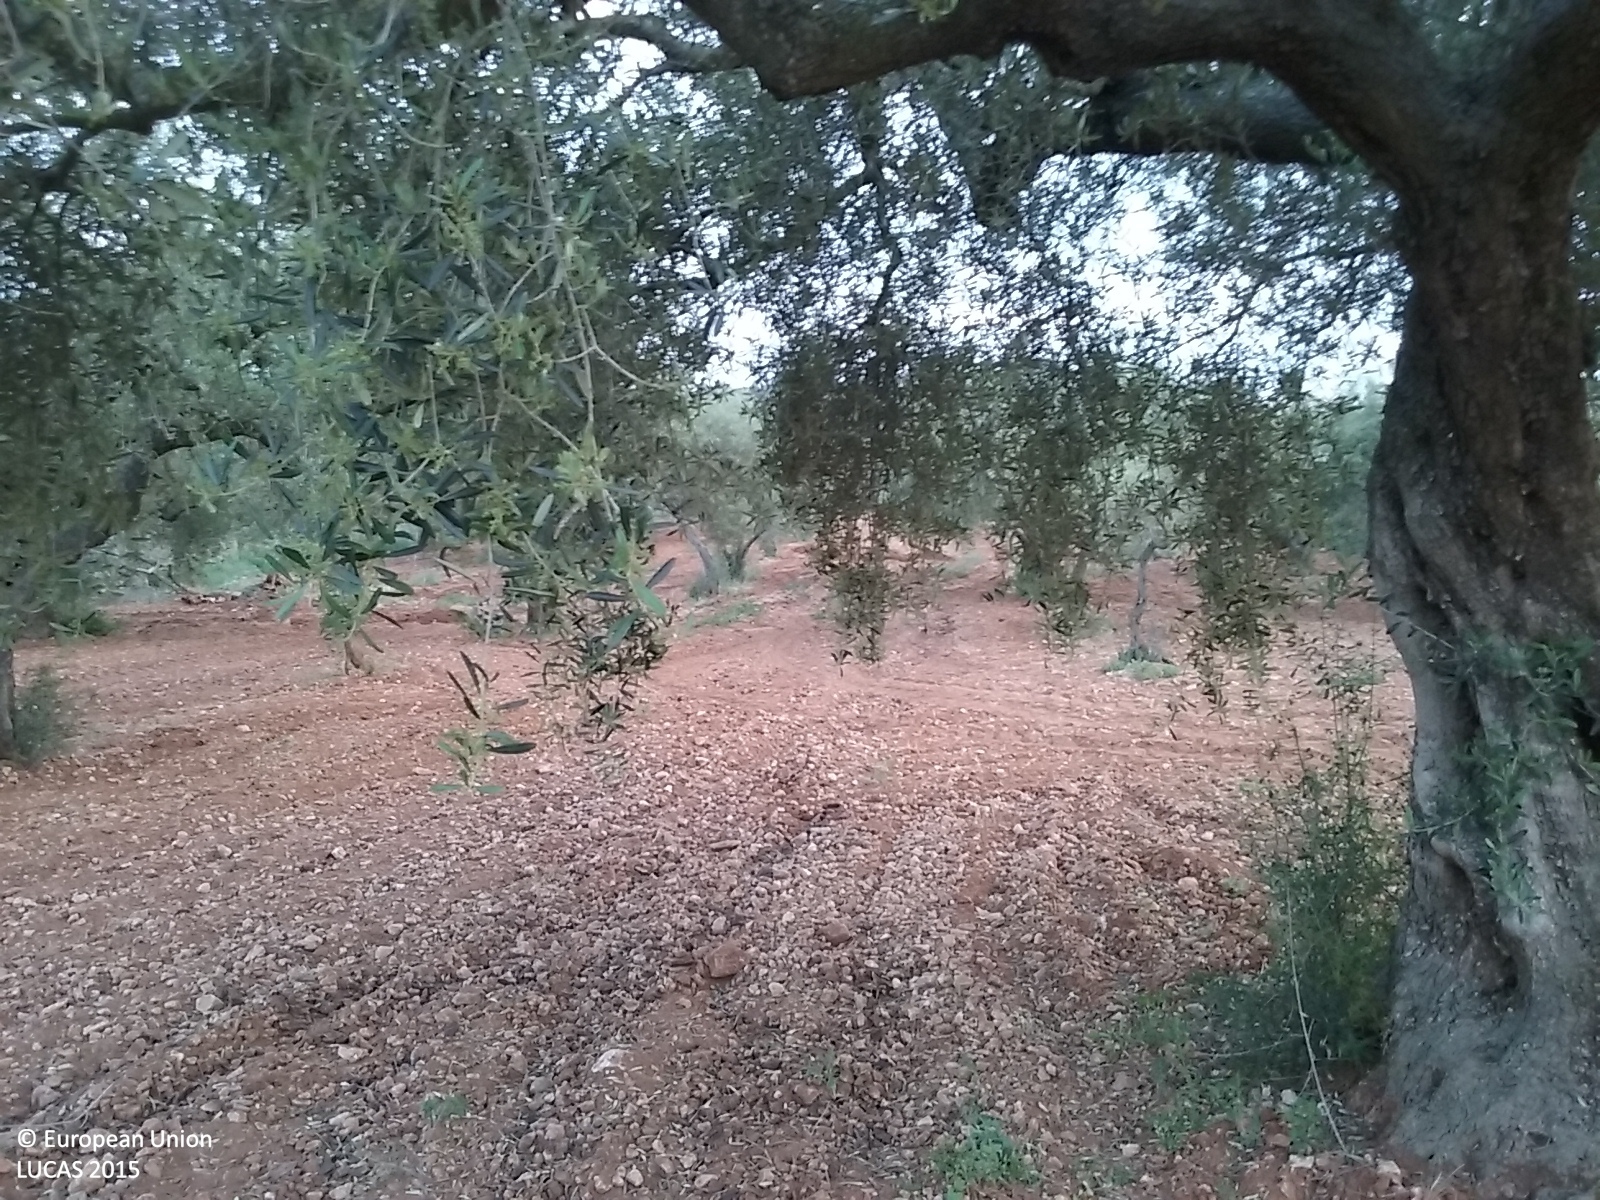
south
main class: Cropland
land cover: Olive groves
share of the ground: 25 - 50 %
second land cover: Other bare soil
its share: > 75 %
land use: Agriculture (excluding fallow land and kitchen gardens)
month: April
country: ES
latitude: 40.2940
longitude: 0.1033
